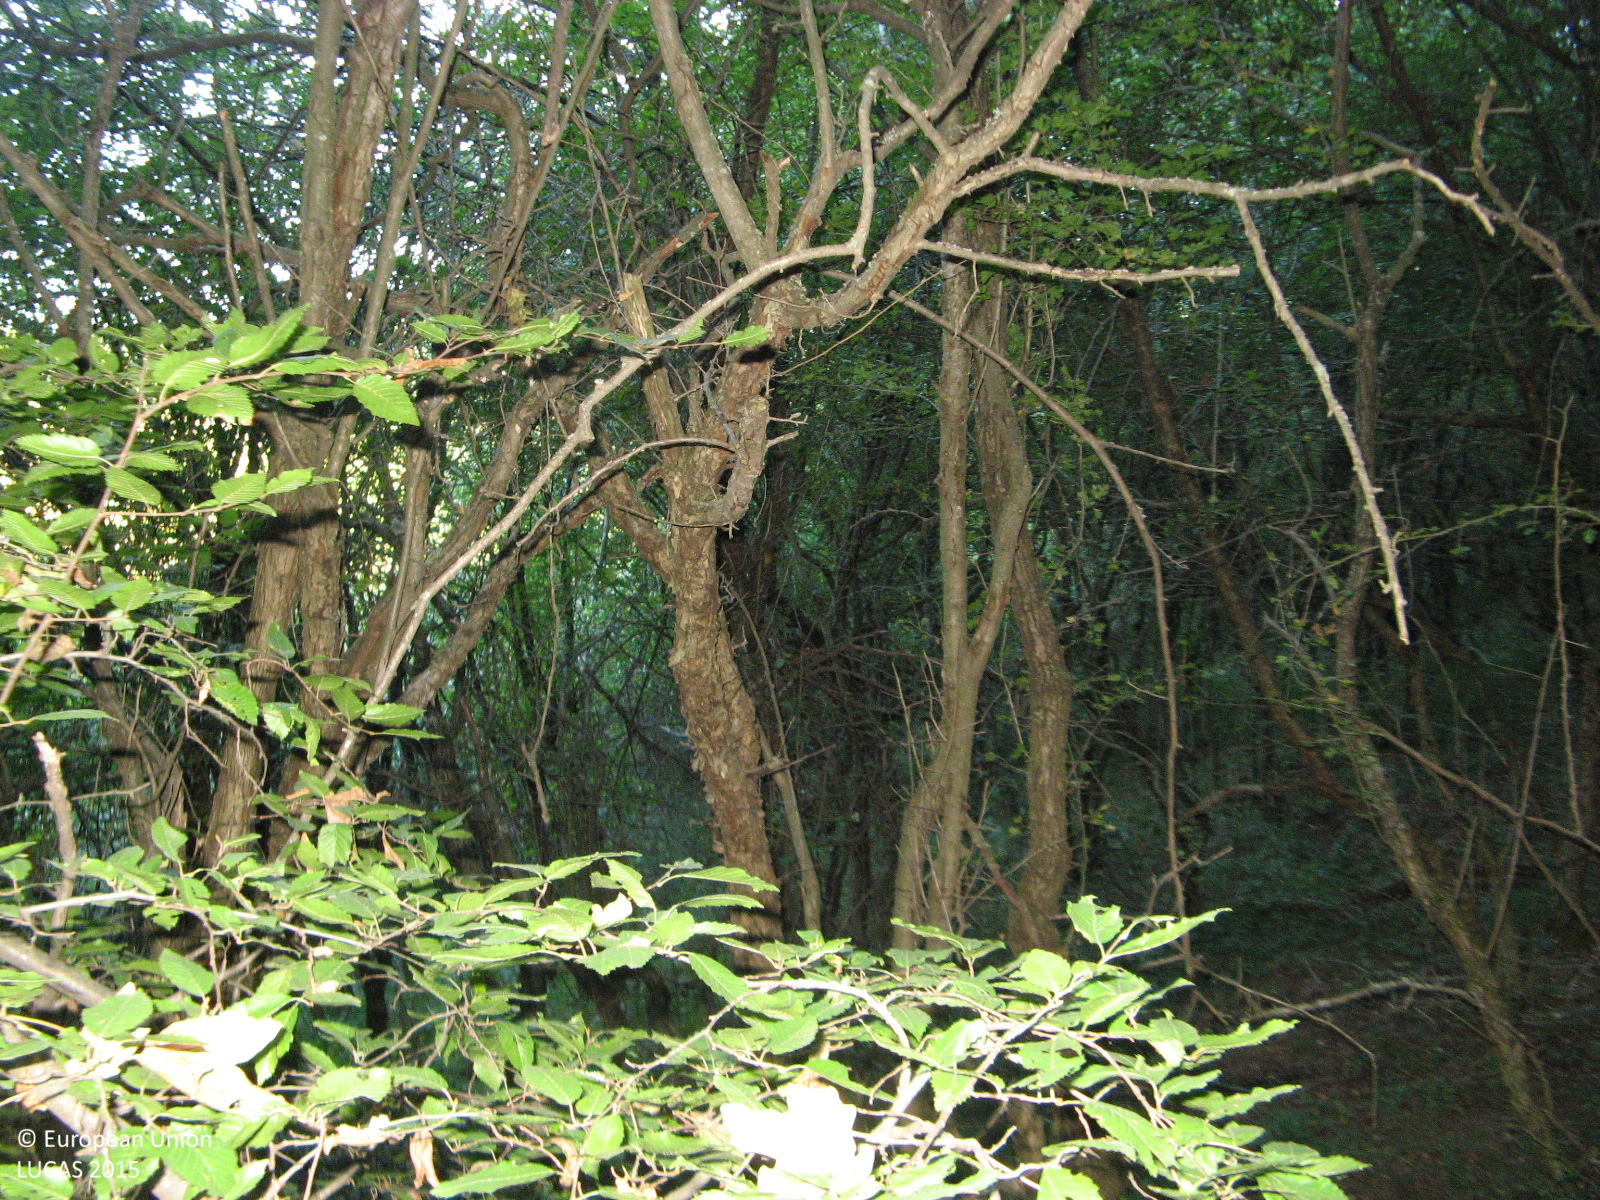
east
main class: Woodland
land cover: Broadleaved woodland
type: thermophilous deciduous forest
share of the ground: > 75 %
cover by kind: broadleaved forest trees 95 %, shrubs 5 %
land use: Forestry
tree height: > 5 m
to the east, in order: Broadleaved woodland; Shrubland with sparse tree cover
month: September
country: BG
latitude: 43.5467
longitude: 26.0737
